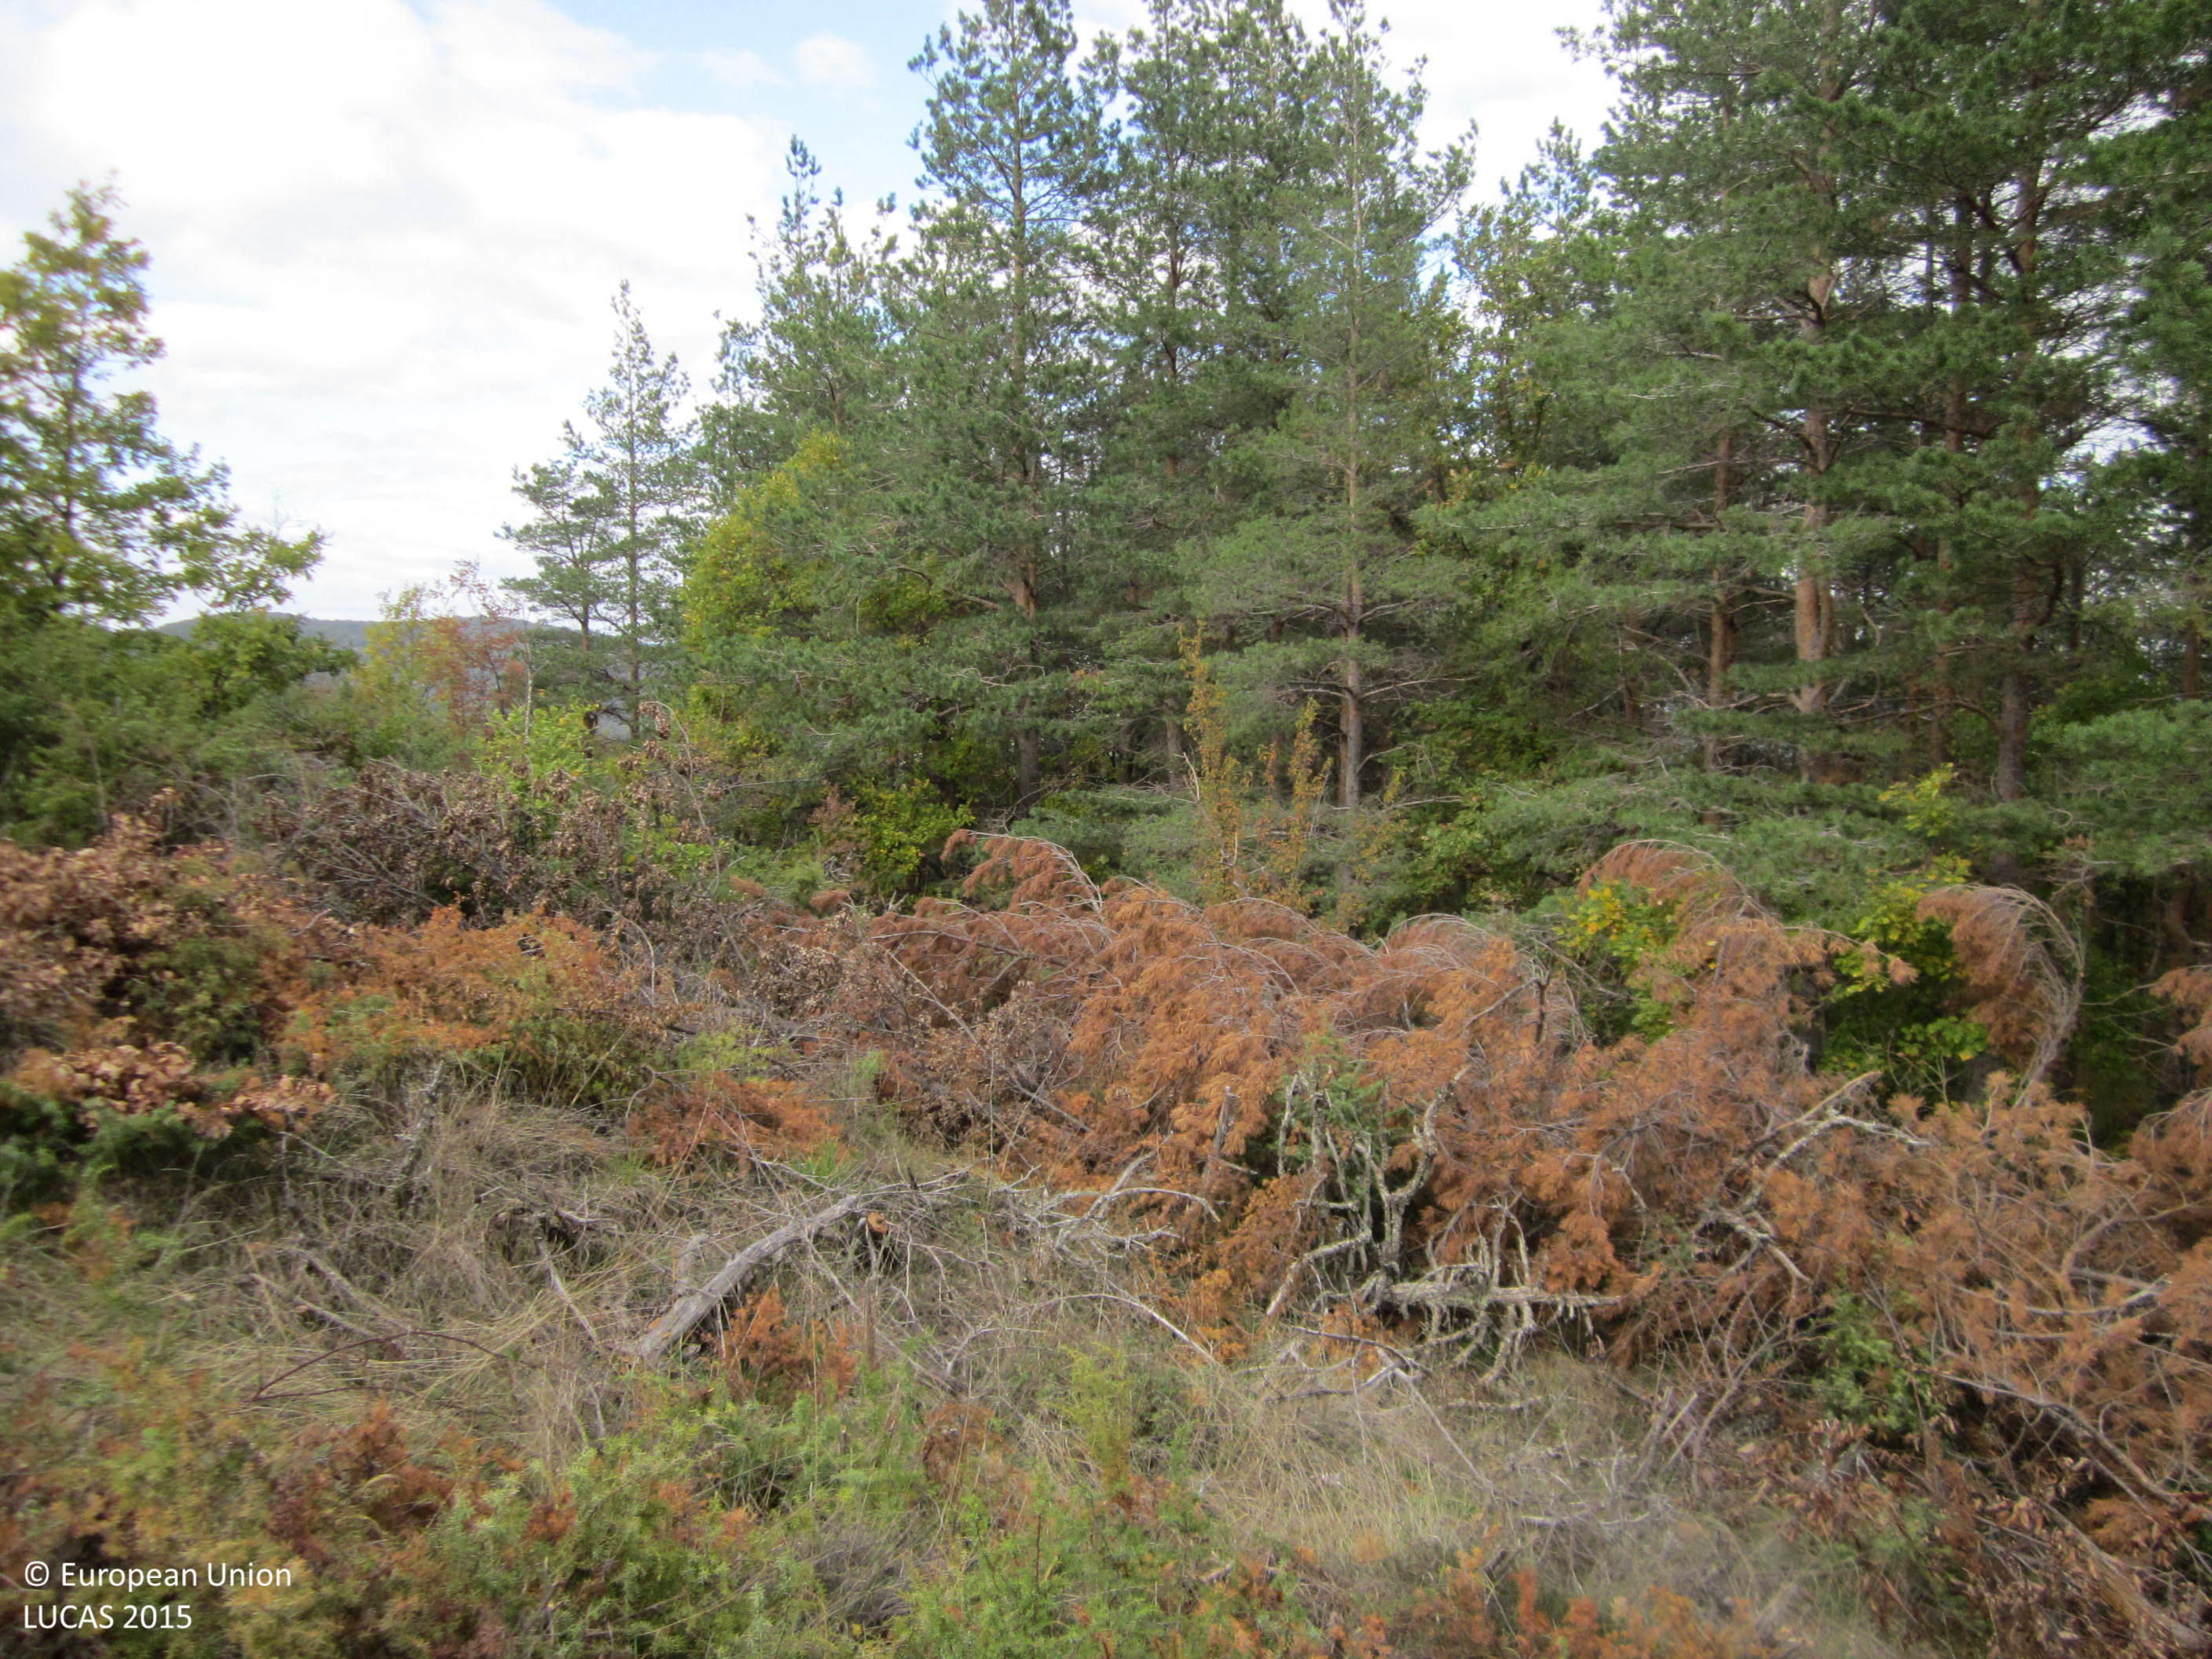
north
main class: Woodland
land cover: Broadleaved woodland
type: mesophytic deciduous forest
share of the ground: 50 - 75 %
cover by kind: broadleaved forest trees 50 %, herbaceous plants 25 %, shrubs 20 %, coniferous forest trees 5 %
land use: Forestry
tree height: > 5 m
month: November
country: BG
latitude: 41.3770
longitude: 25.8581
